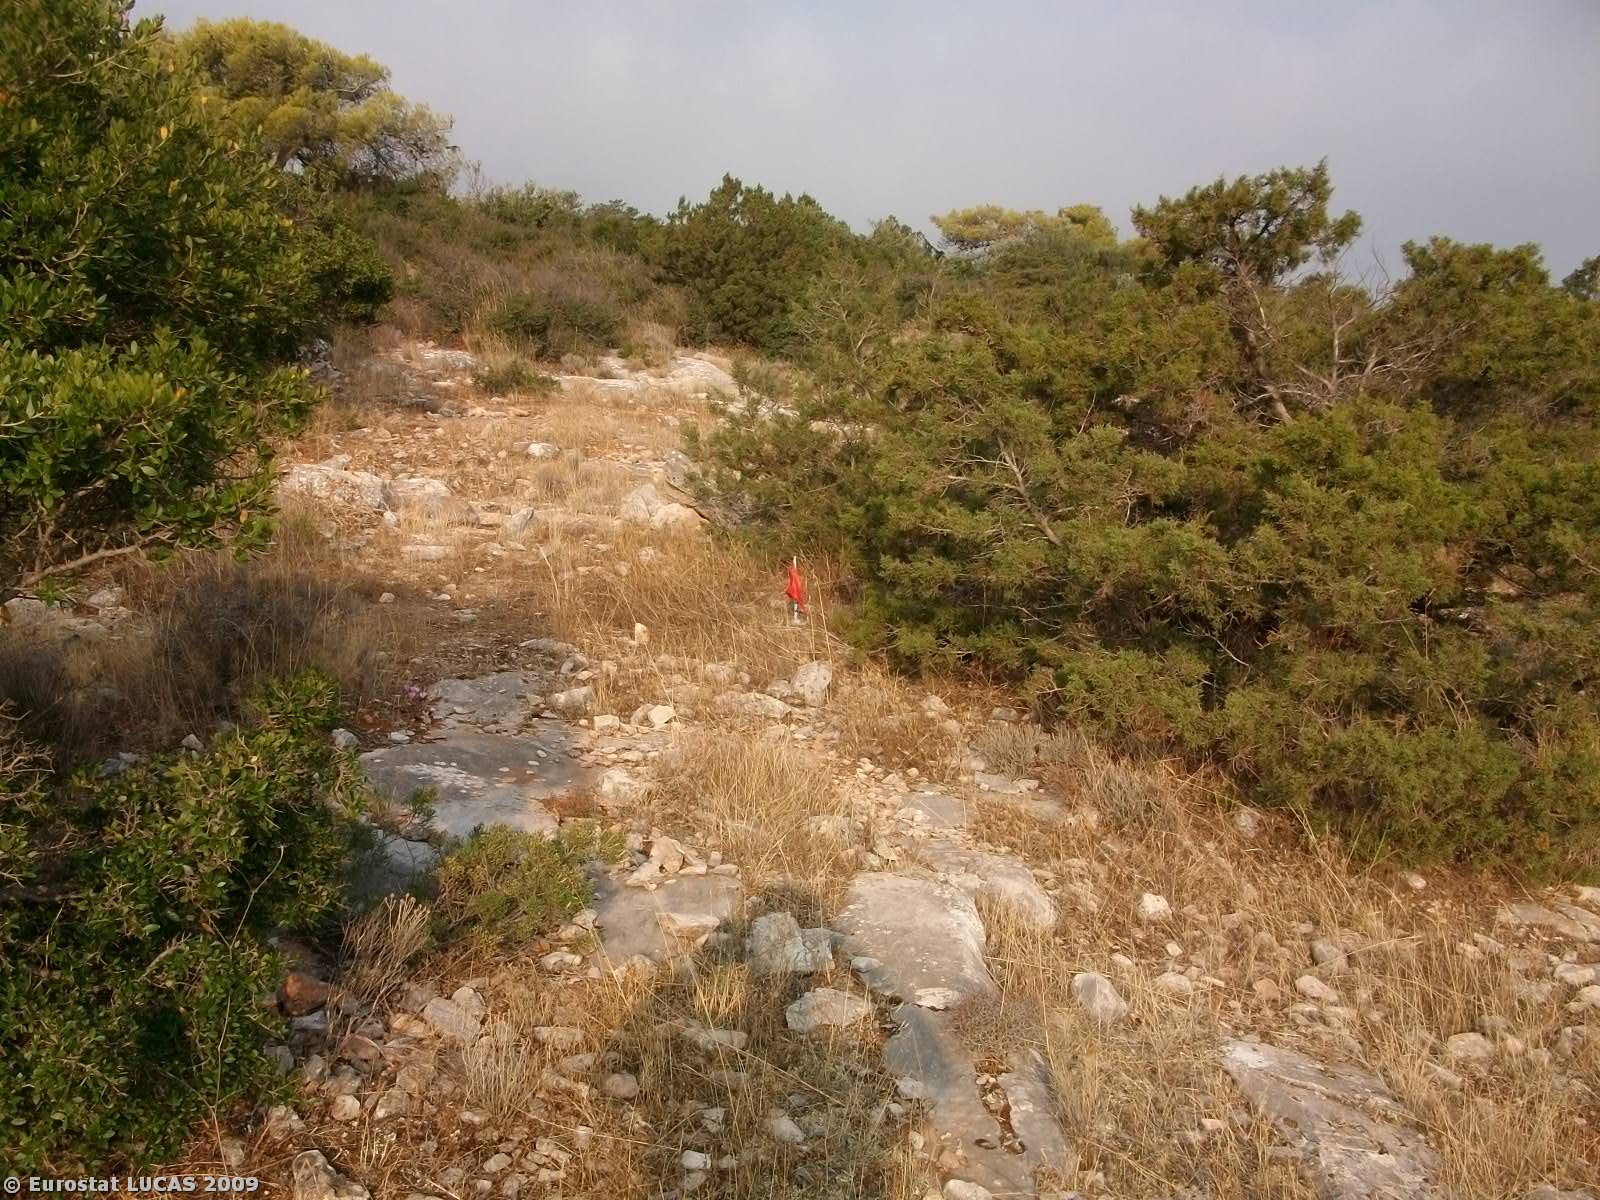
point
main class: Shrubland
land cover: Shrubland with sparse tree cover
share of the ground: 50 - 75 %
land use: Unused
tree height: < 5 m
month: October
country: GR
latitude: 37.8270
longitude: 23.8746
